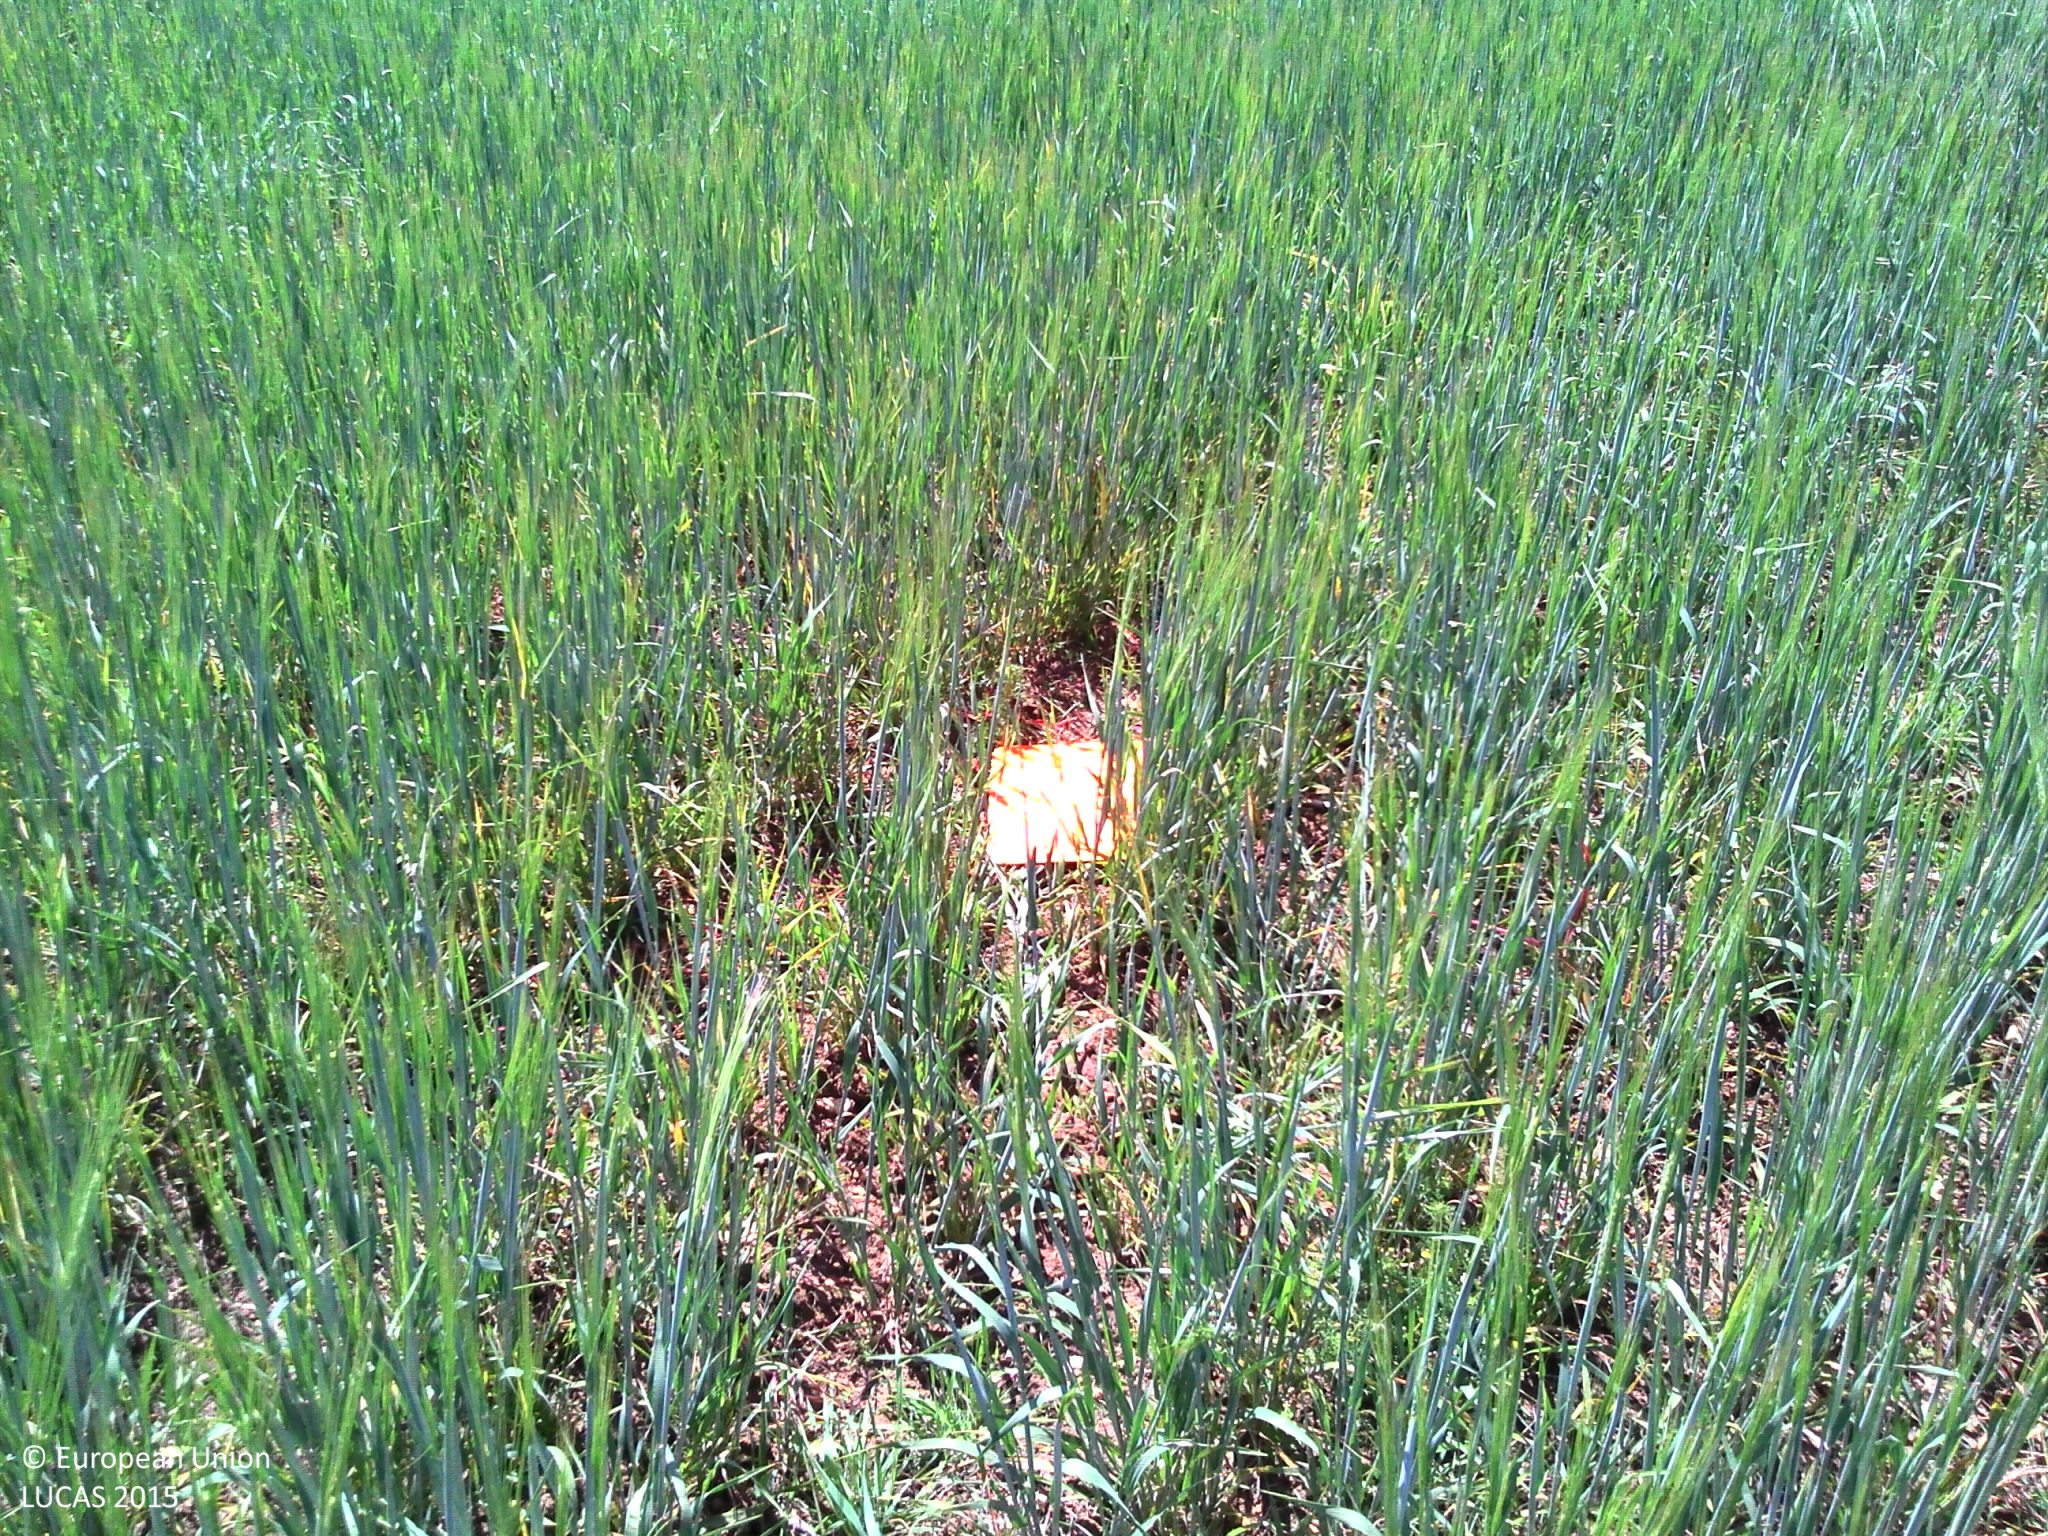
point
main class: Cropland
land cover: Barley
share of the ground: > 75 %
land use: Agriculture (excluding fallow land and kitchen gardens)
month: June
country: FR
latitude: 46.5175
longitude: 0.6116
